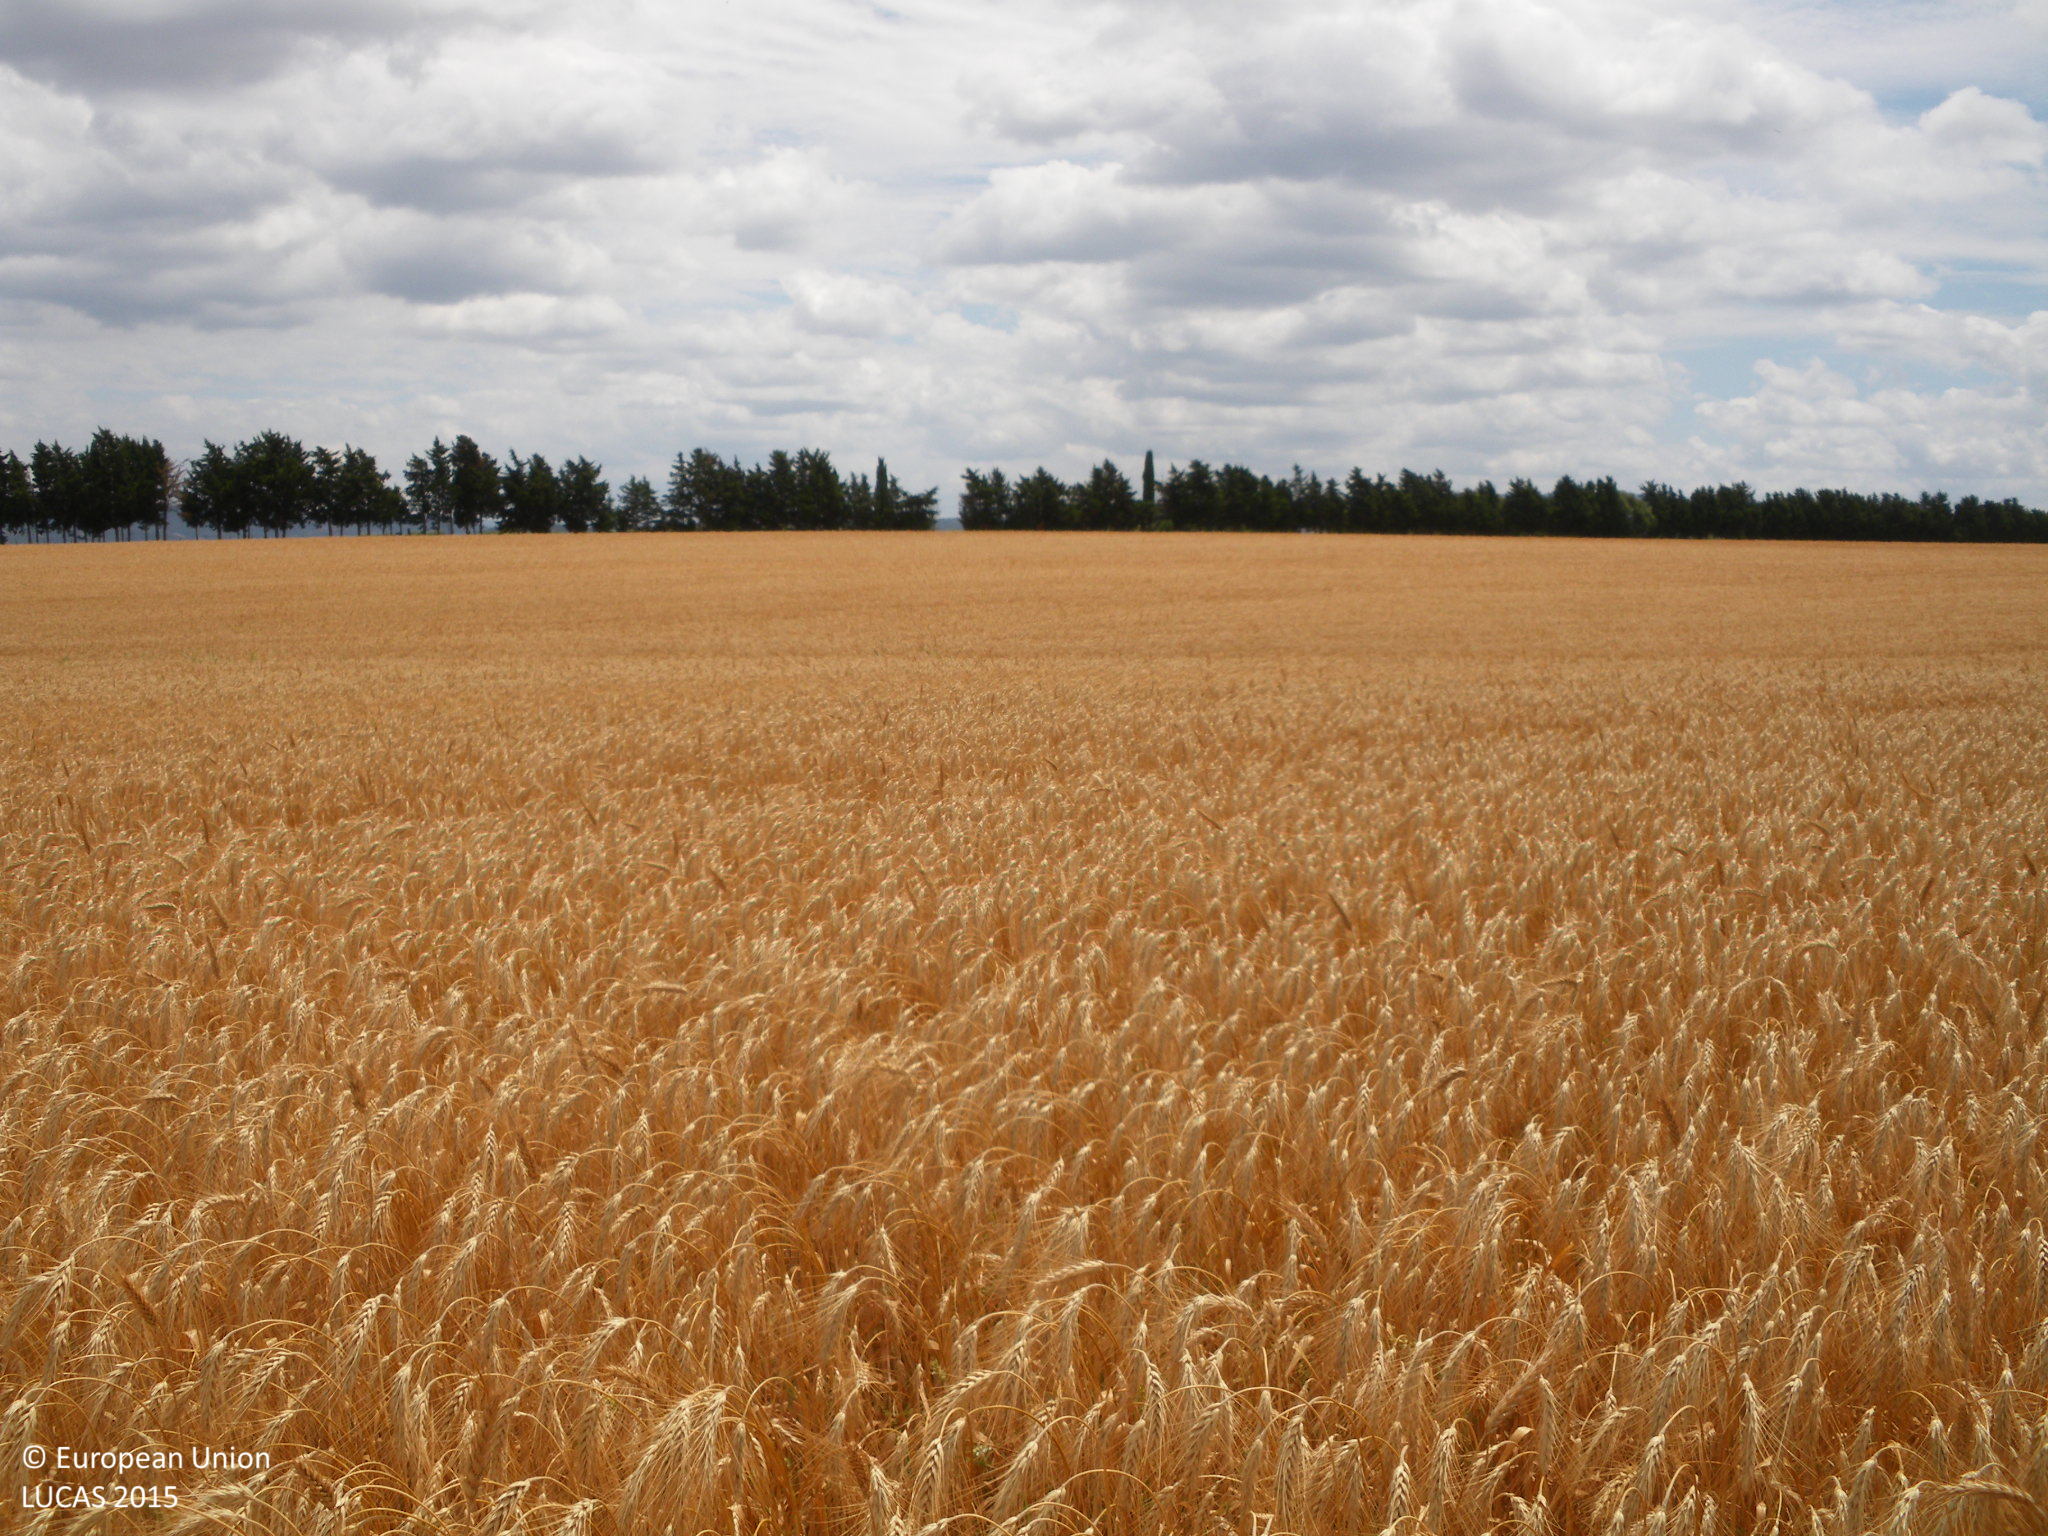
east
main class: Cropland
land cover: Durum wheat
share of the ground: > 75 %
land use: Agriculture (excluding fallow land and kitchen gardens)
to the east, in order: Durum wheat; Grassland without tree/shrub cover
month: June
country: ES
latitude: 36.2850
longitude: -5.8203
